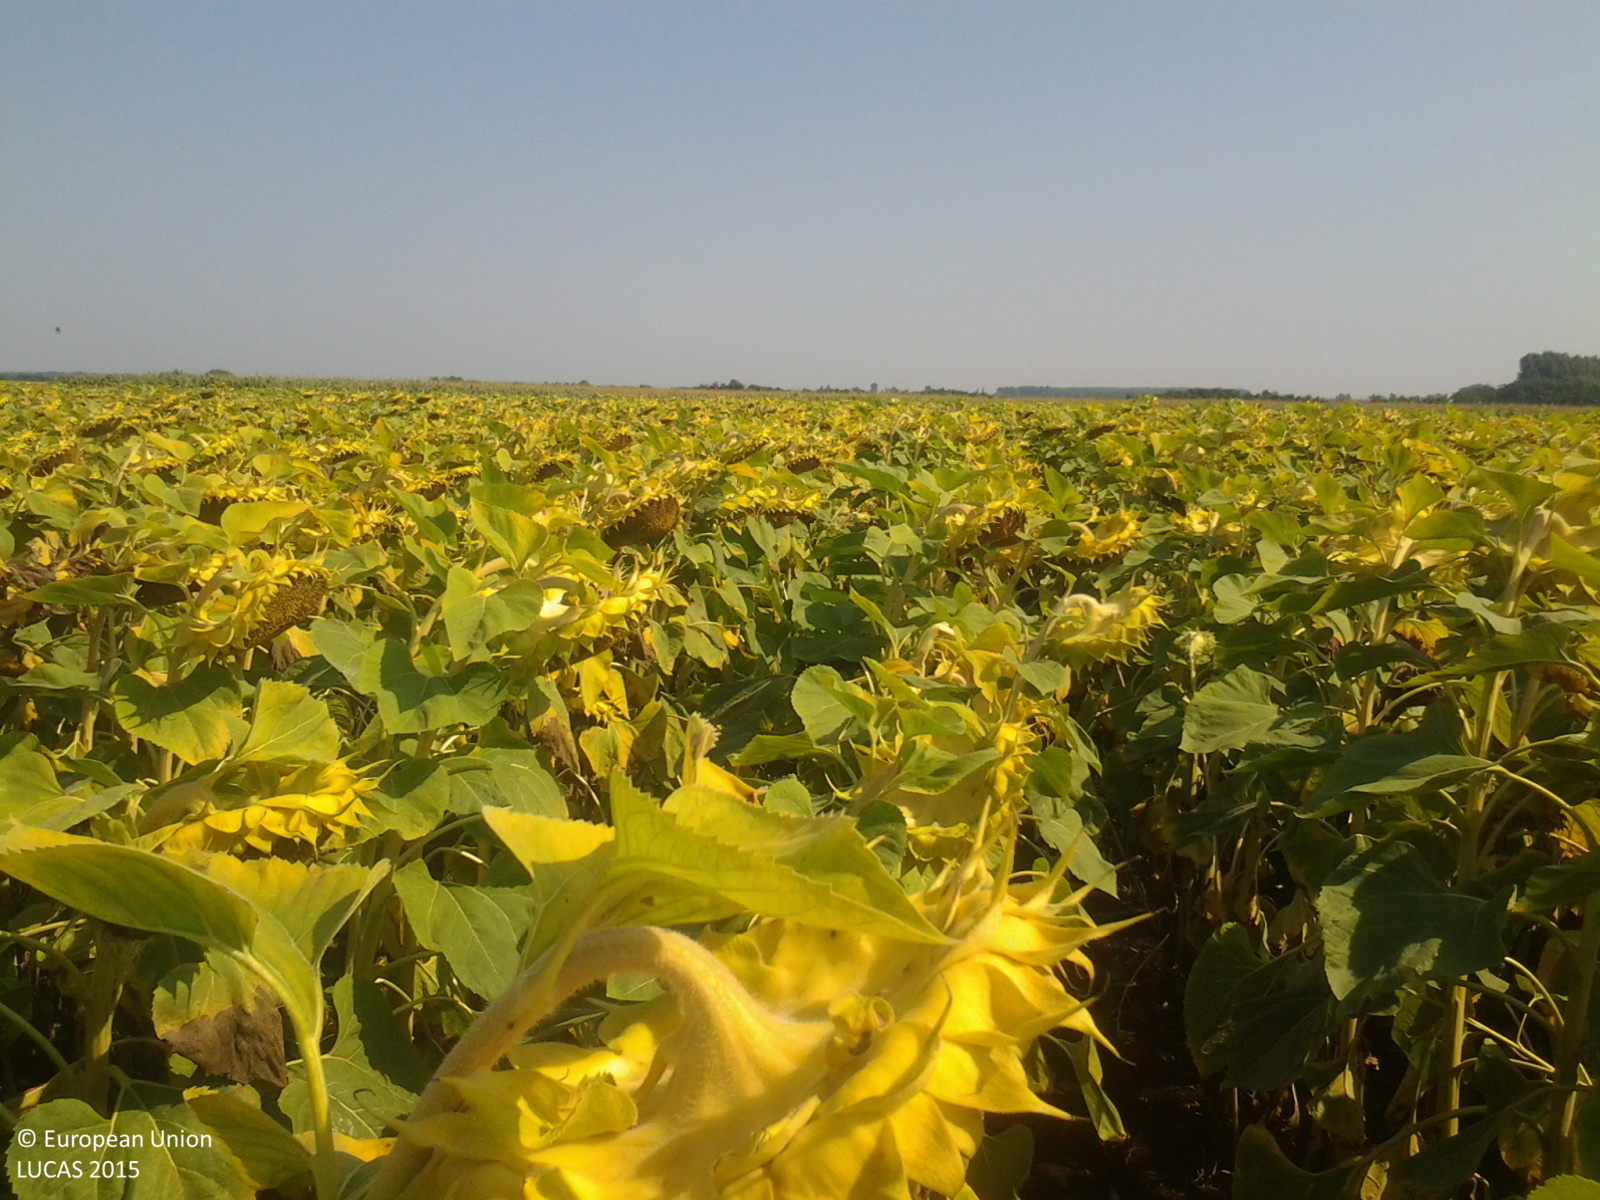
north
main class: Cropland
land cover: Sunflower
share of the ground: > 75 %
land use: Agriculture (excluding fallow land and kitchen gardens)
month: August
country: HU
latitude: 46.9051
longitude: 21.2082
